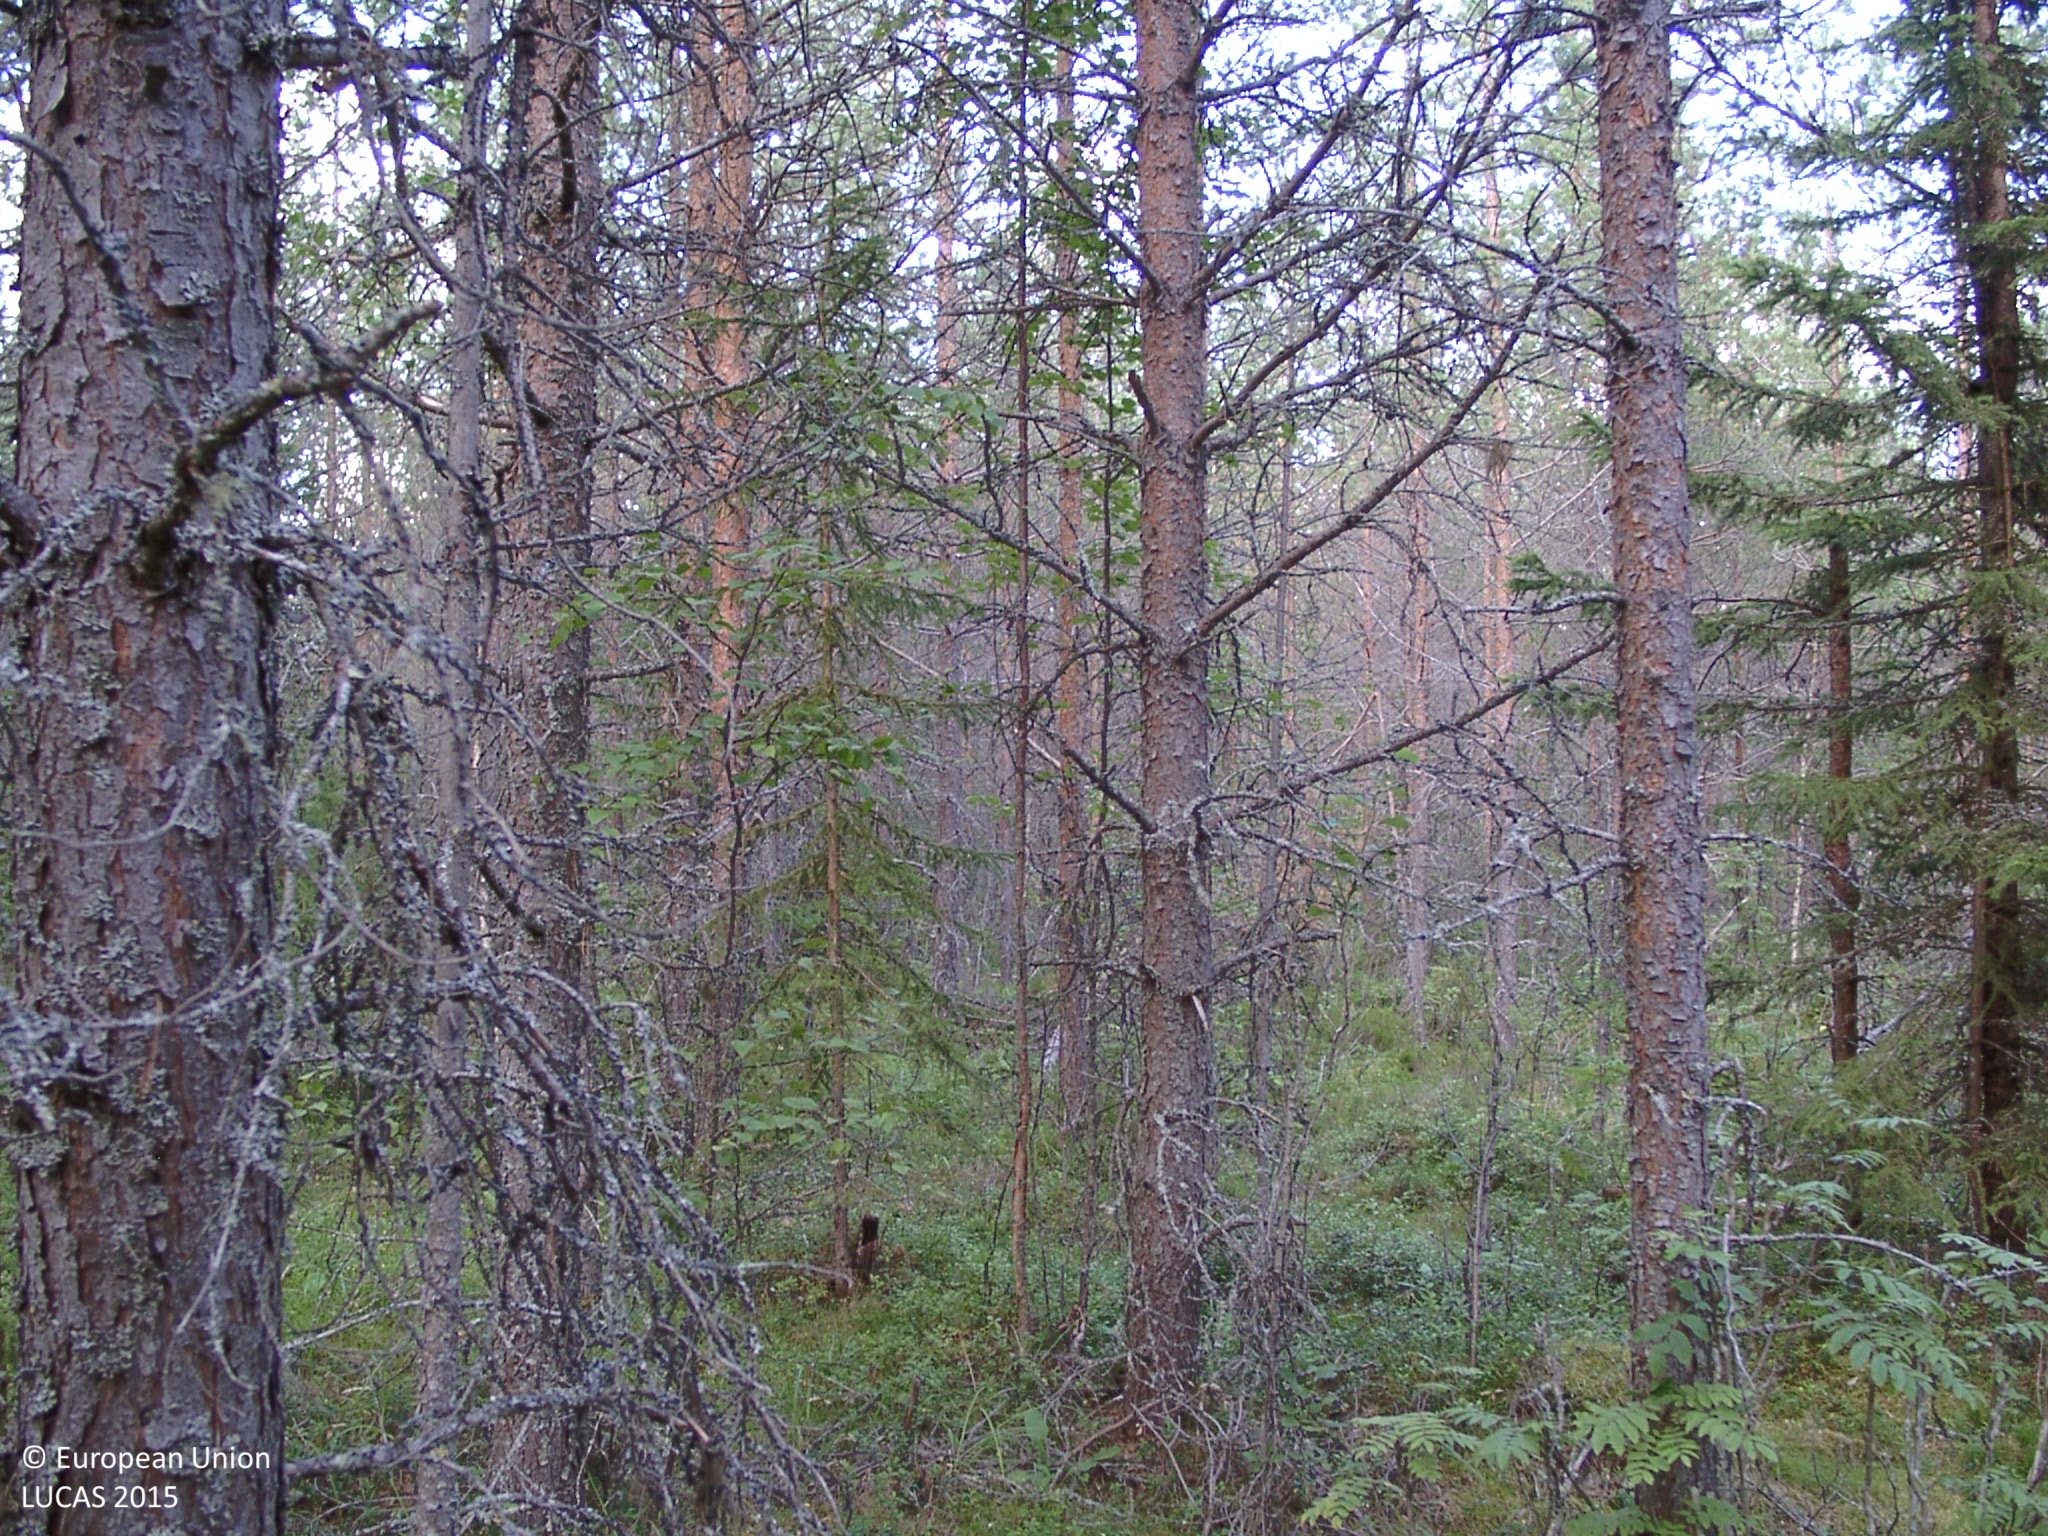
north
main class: Woodland
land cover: Pine dominated coniferous woodland
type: boreal forest
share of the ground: > 75 %
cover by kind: coniferous forest trees 75 %, shrubs 10 %, lichens and mosses 10 %, herbaceous plants 5 %
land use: Forestry
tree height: > 5 m
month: August
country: FI
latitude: 62.9718
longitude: 25.0681
